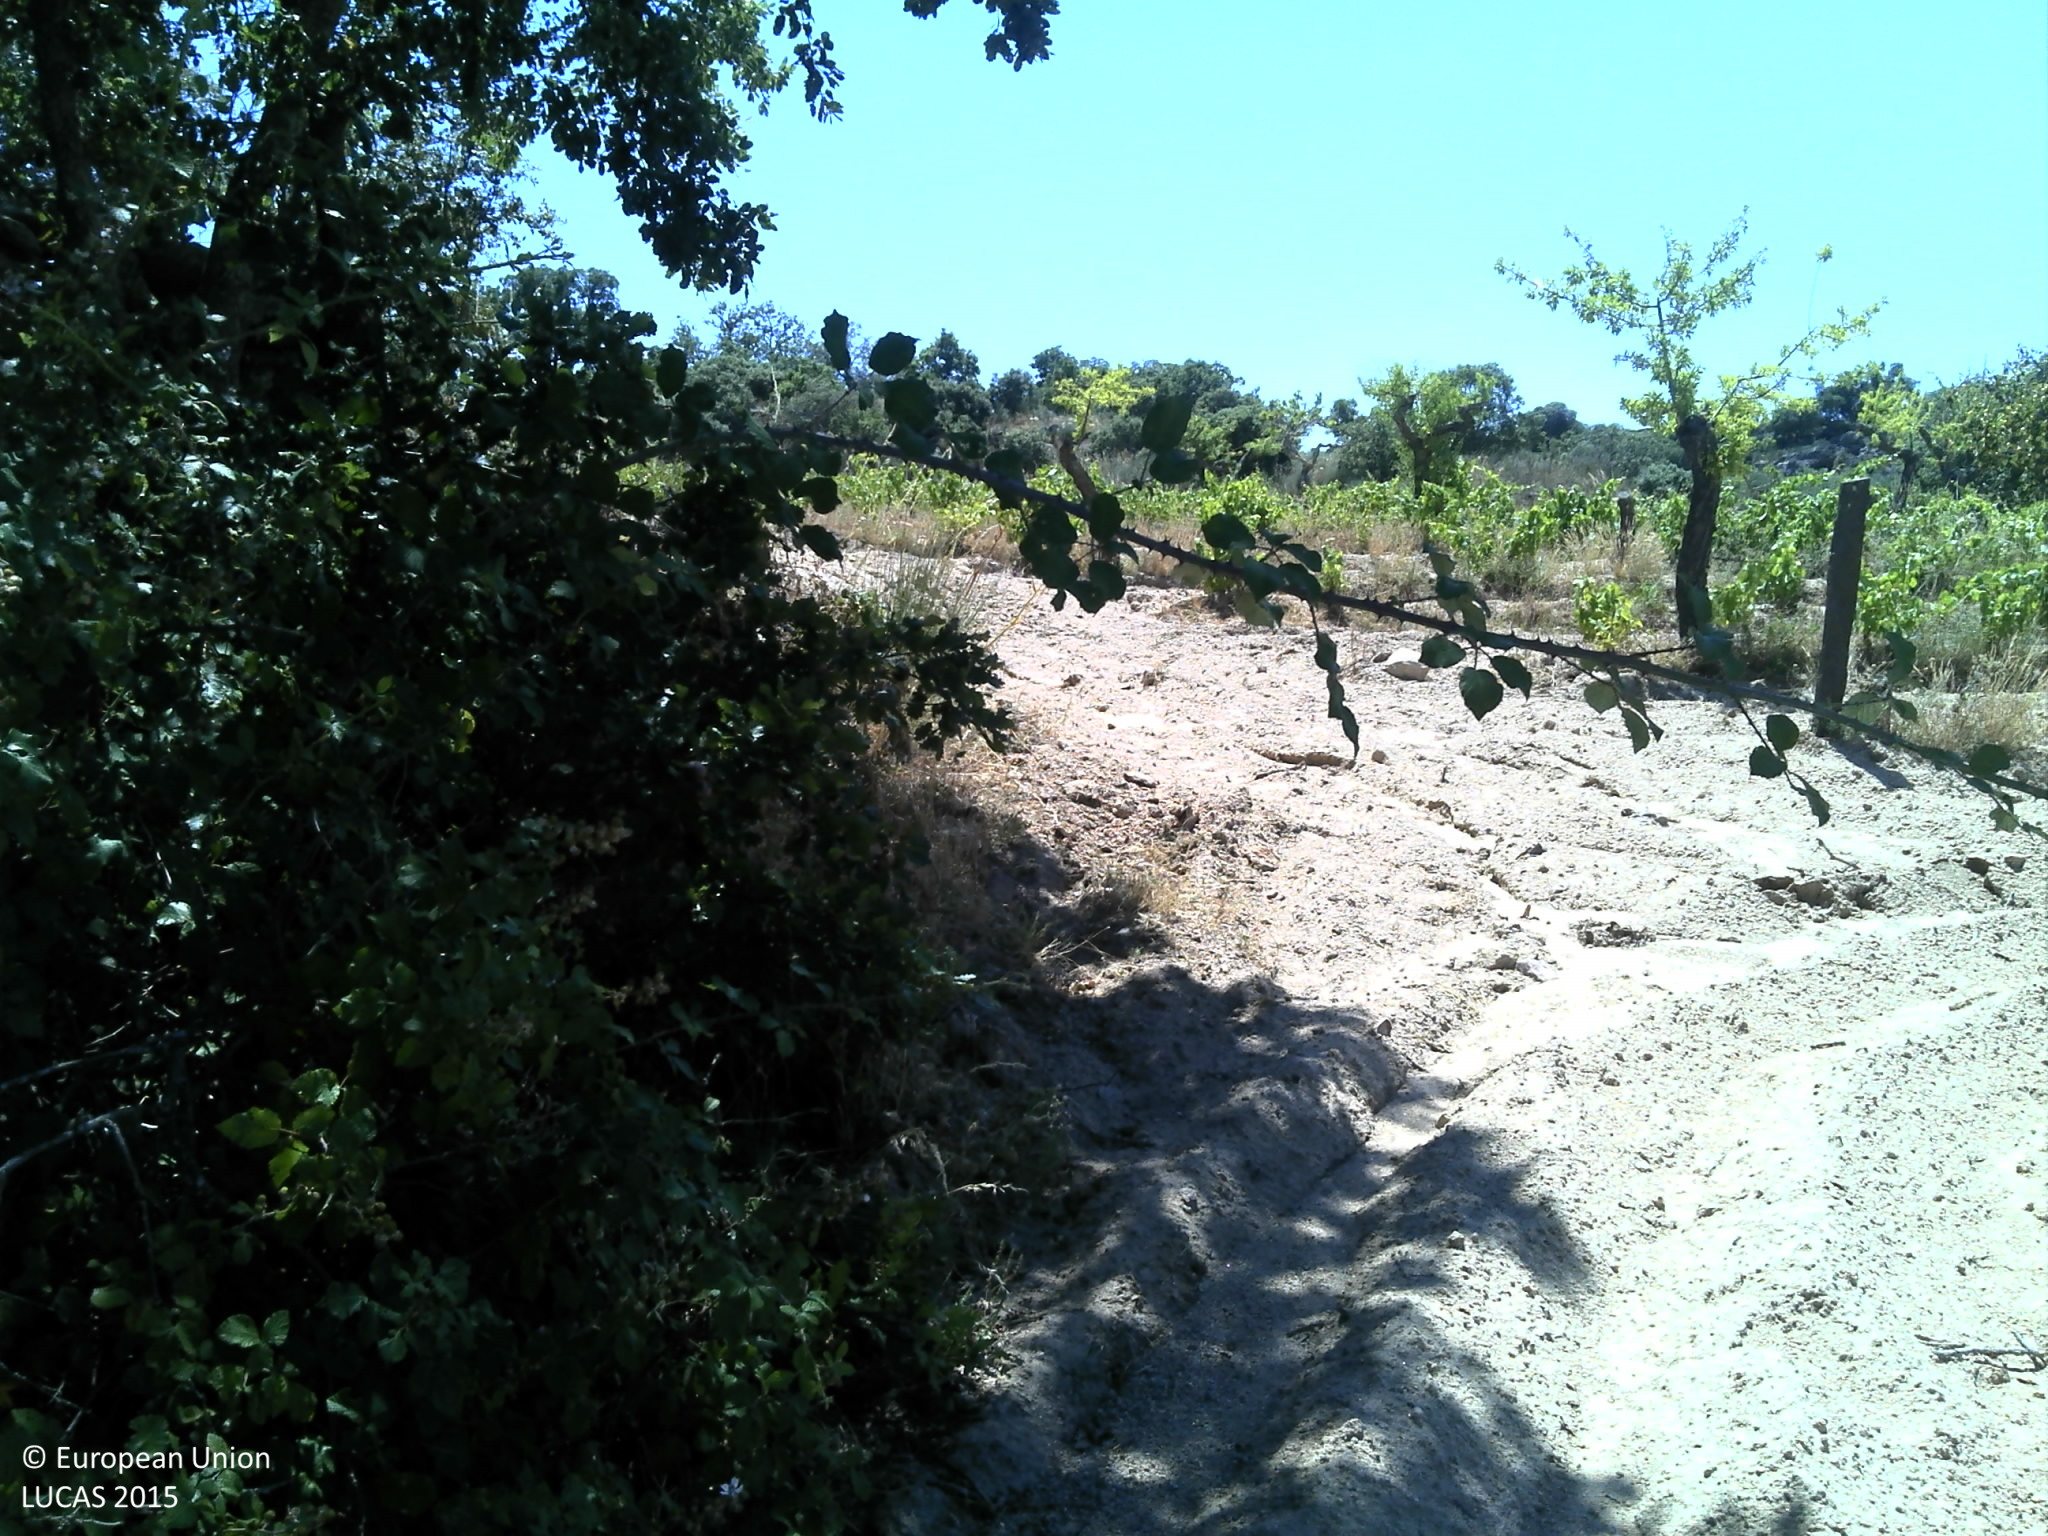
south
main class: Cropland
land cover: Vineyards
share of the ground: < 10 %
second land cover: Other bare soil
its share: > 75 %
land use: Agriculture (excluding fallow land and kitchen gardens)
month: June
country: PT
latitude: 40.9274
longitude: -7.0046
